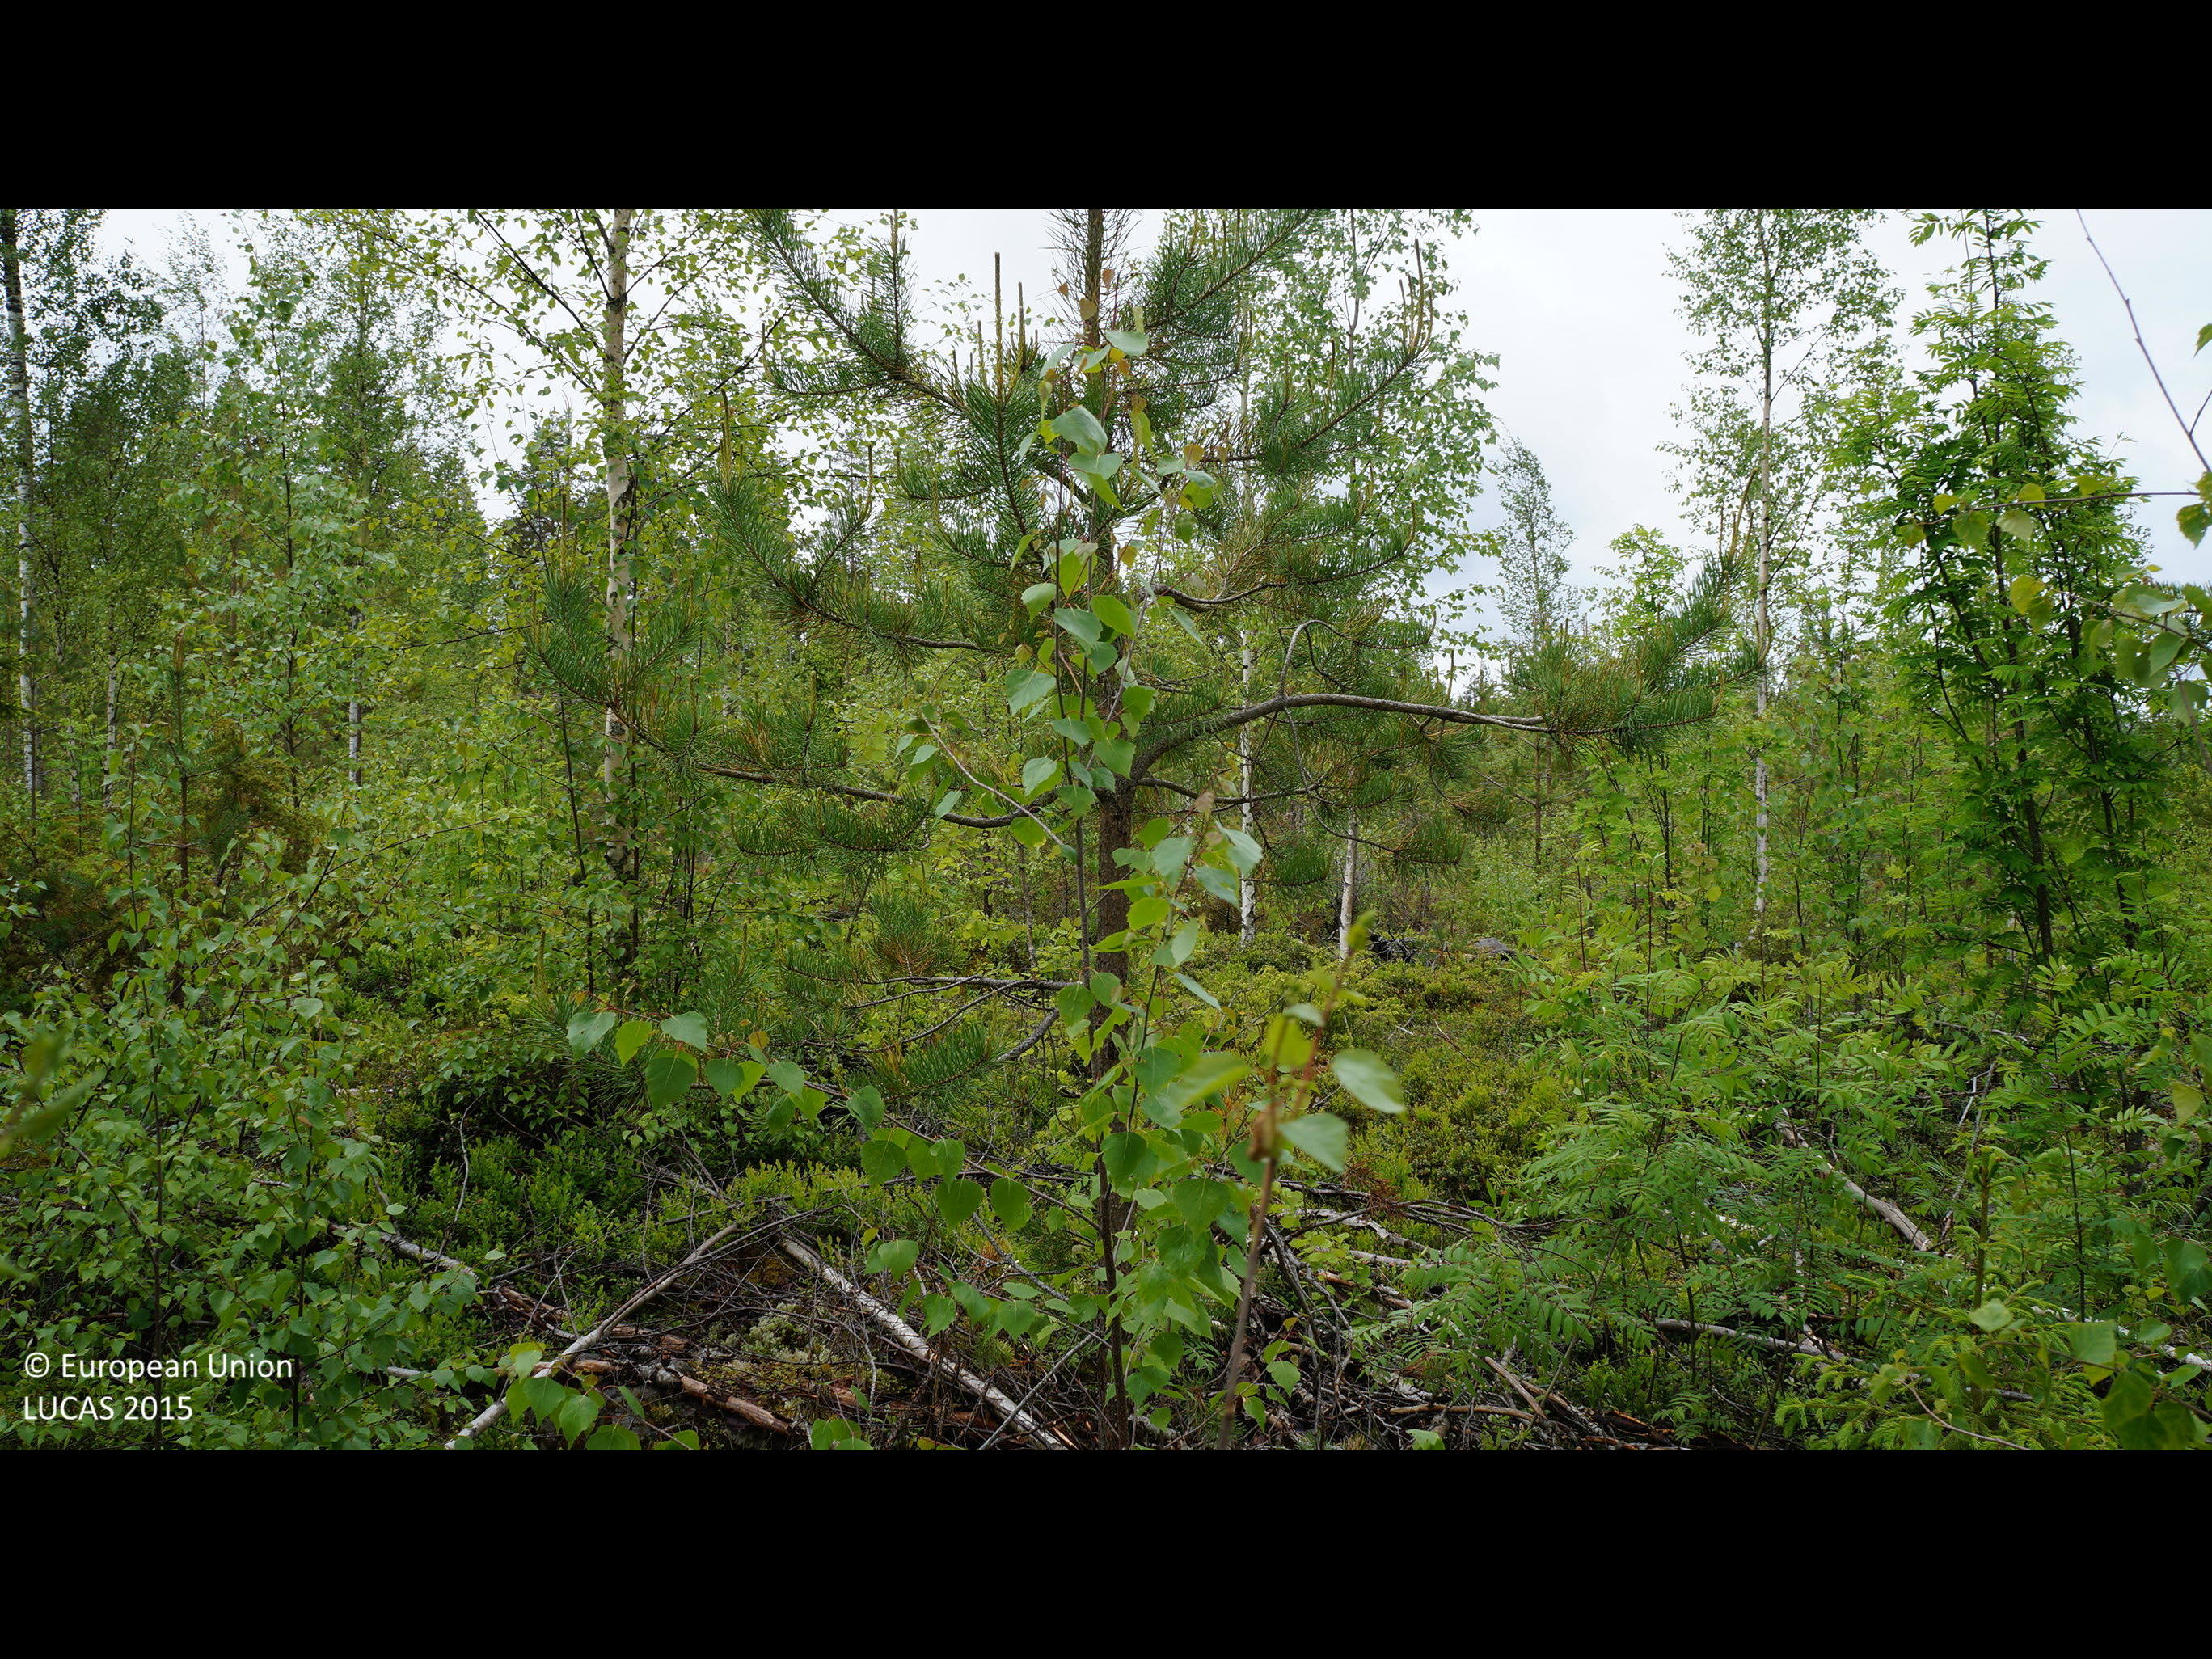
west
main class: Woodland
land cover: Pine dominated mixed woodland
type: boreal forest
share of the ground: 25 - 50 %
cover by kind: shrubs 35 %, broadleaved forest trees 25 %, coniferous forest trees 20 %, herbaceous plants 10 %, lichens and mosses 10 %
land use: Forestry
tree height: > 5 m
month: June
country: FI
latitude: 63.8929
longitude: 24.8912
